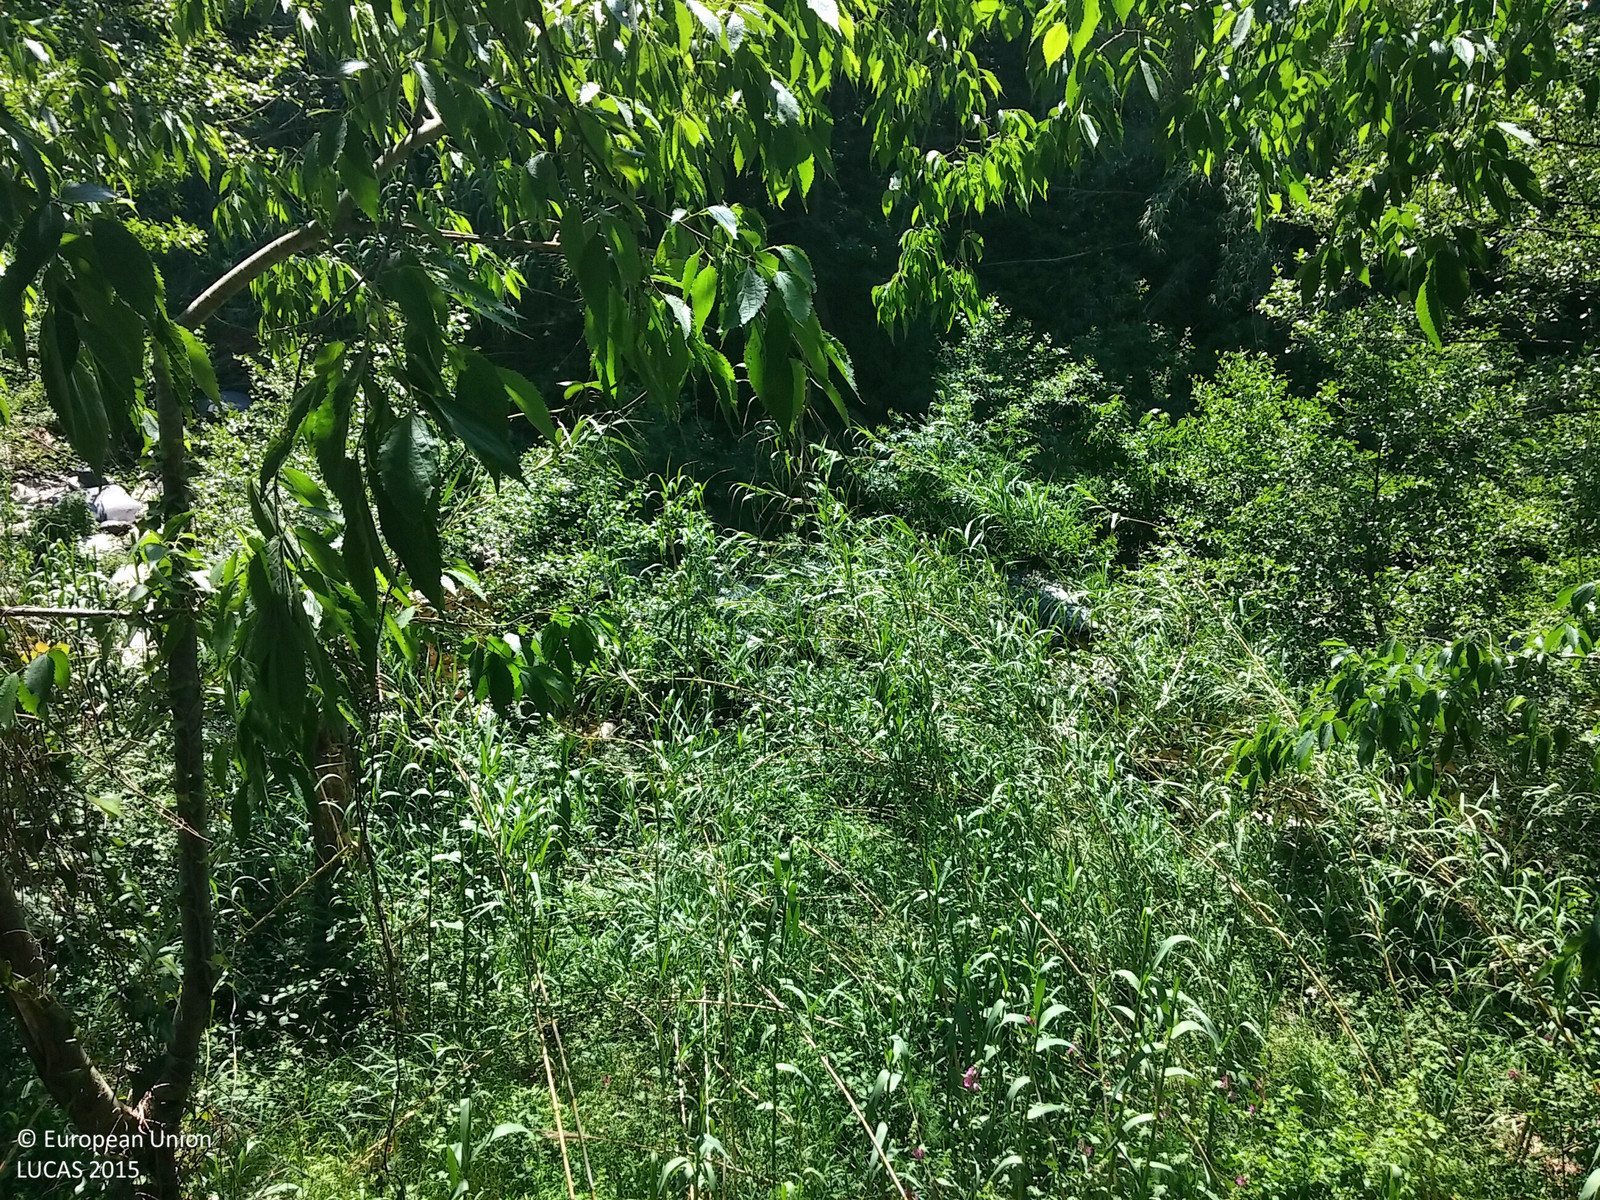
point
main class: Woodland
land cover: Broadleaved woodland
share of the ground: 50 - 75 %
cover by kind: broadleaved forest trees 65 %, shrubs 30 %
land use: Semi-natural and natural areas not in use
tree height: > 5 m
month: May
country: ES
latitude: 42.3775
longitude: 3.0305
